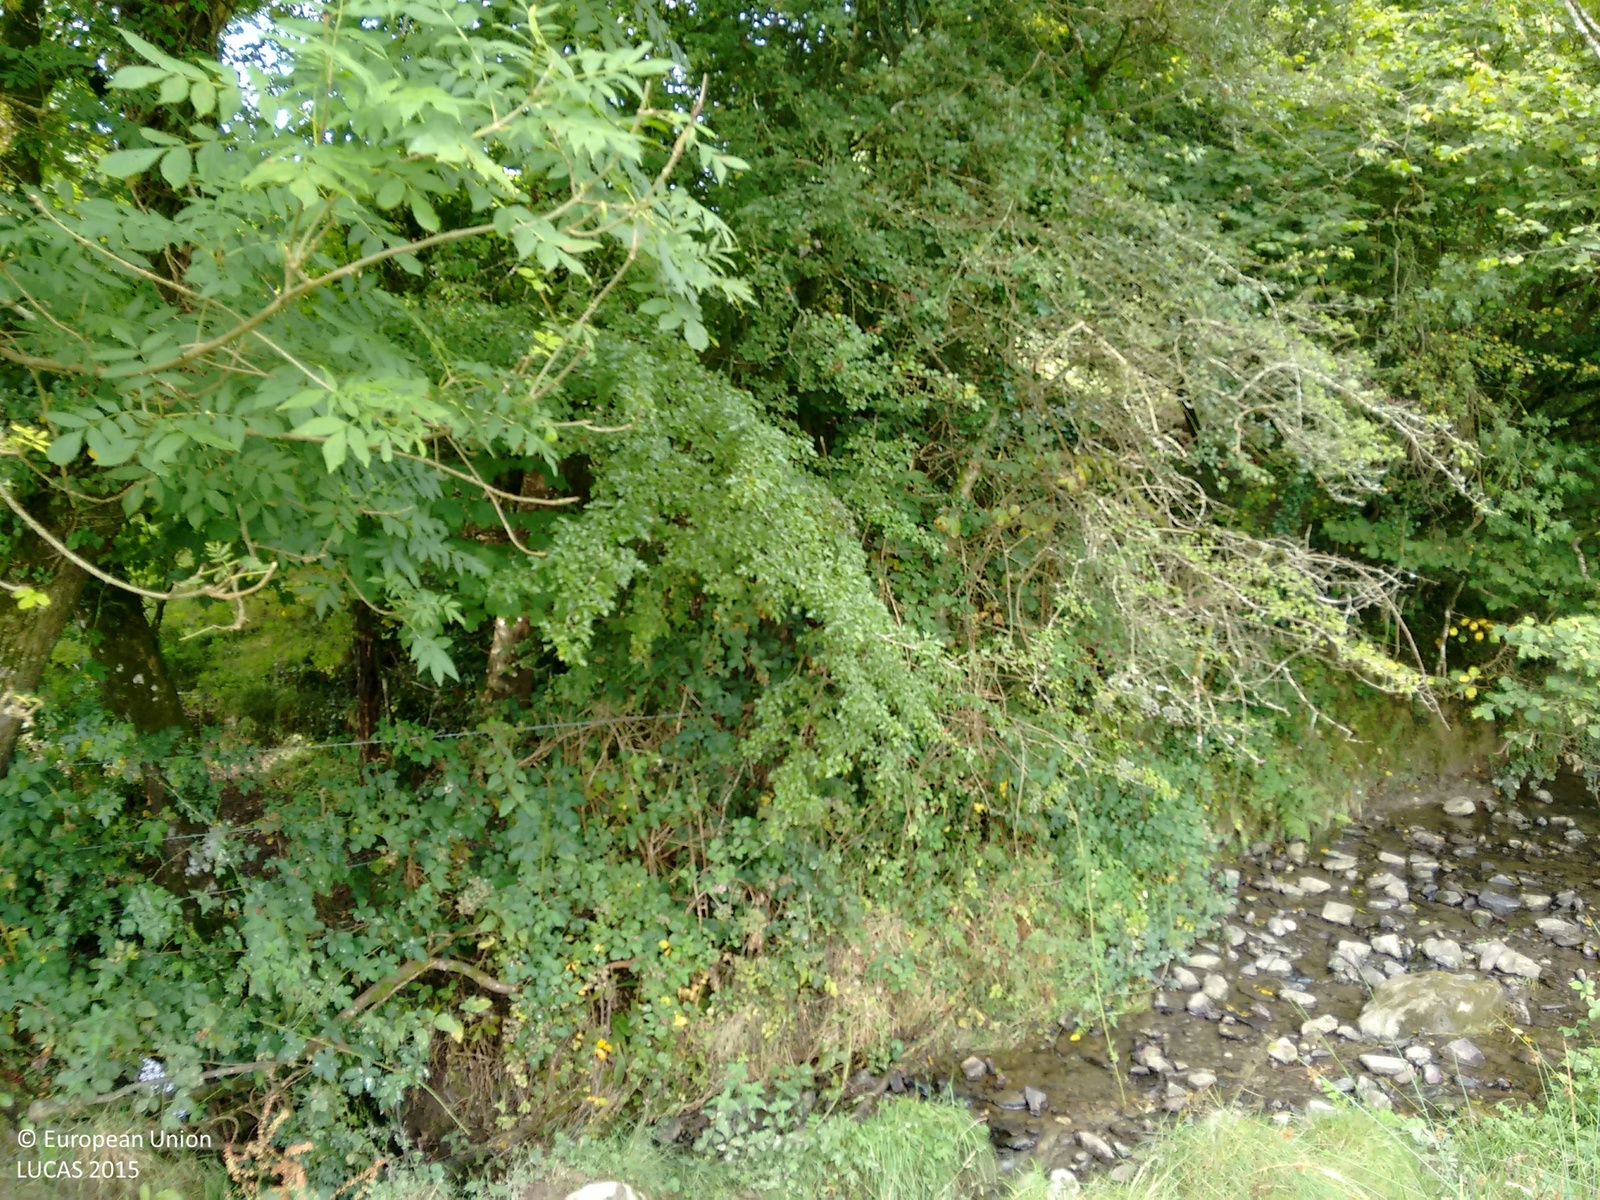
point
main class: Woodland
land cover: Broadleaved woodland
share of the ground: > 75 %
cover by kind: broadleaved forest trees 90 %, herbaceous plants 10 %
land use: Agriculture (excluding fallow land and kitchen gardens)
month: September
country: GB
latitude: 52.0653
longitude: -4.5030
